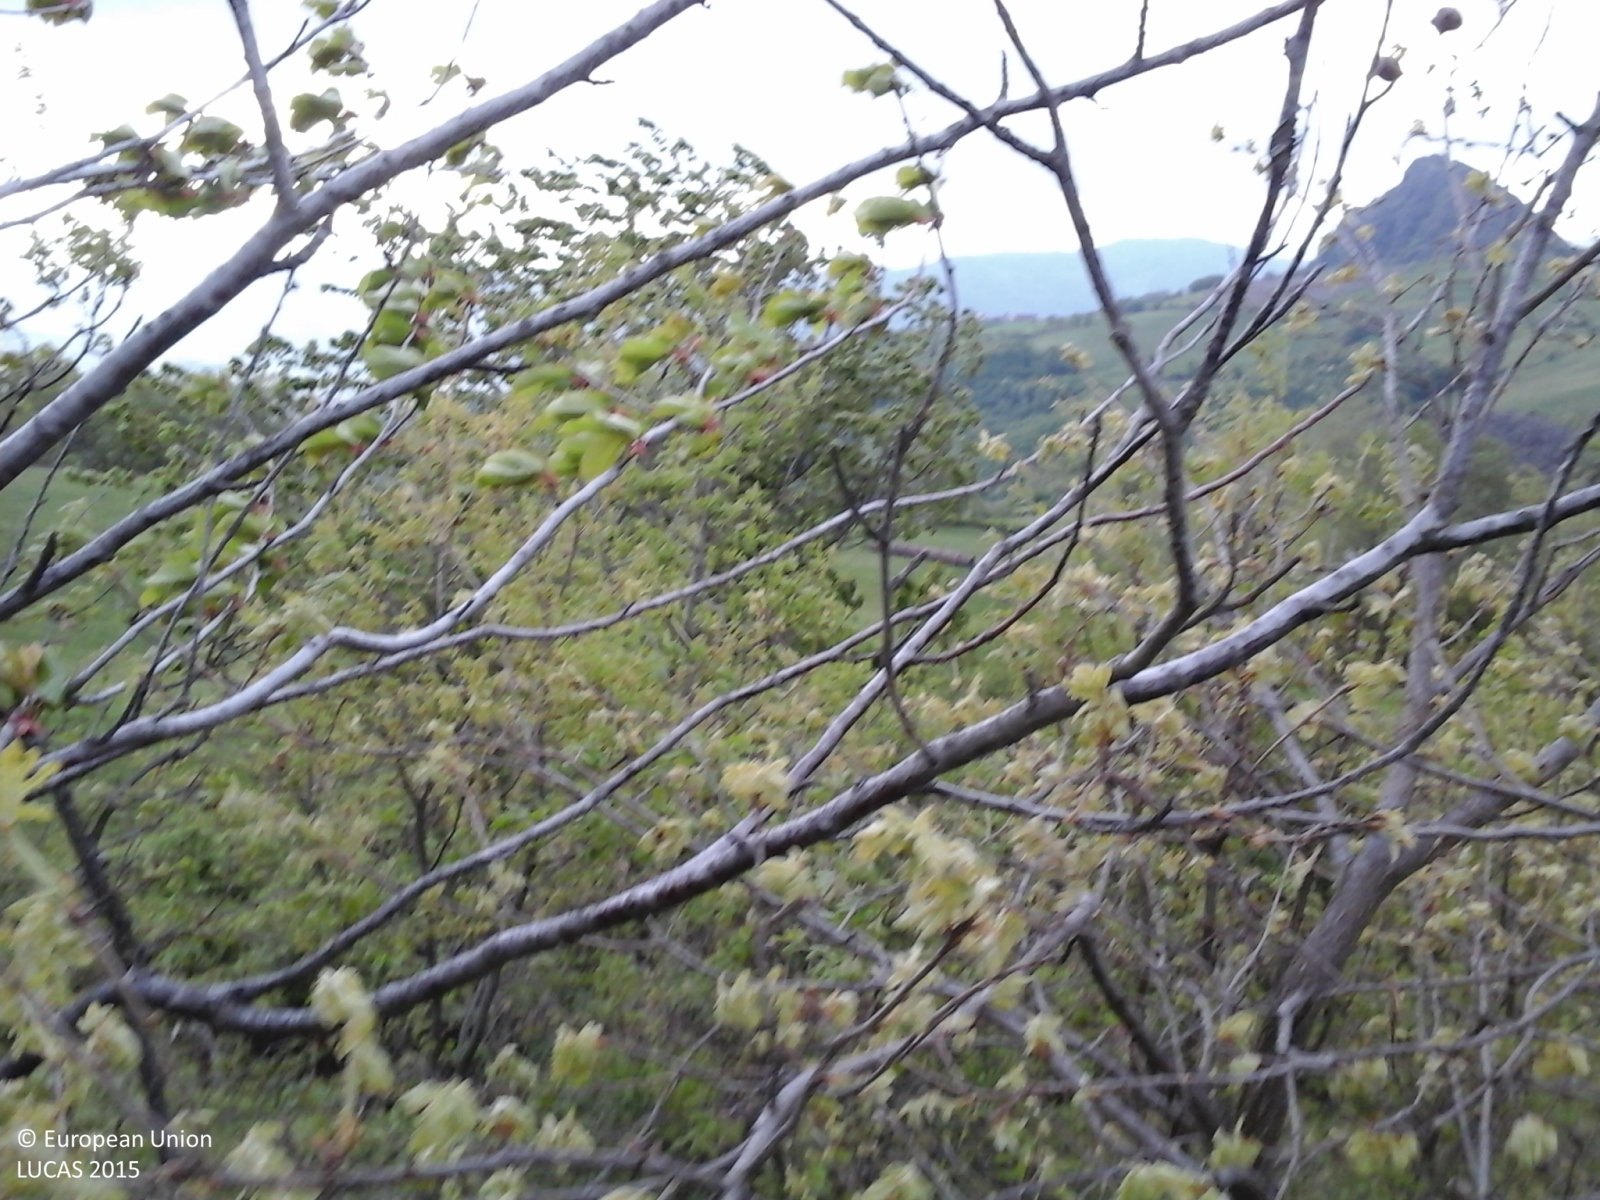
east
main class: Woodland
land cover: Broadleaved woodland
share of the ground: > 75 %
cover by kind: broadleaved forest trees 70 %, shrubs 20 %, herbaceous plants 10 %
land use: Forestry
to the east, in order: Broadleaved woodland; Rivers and streams; Broadleaved woodland; Lucerne; Grassland without tree/shrub cover; Paved roads, cycling and walking lanes; Grass margins; Lucerne
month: May
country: IT
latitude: 44.8541
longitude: 9.4570
